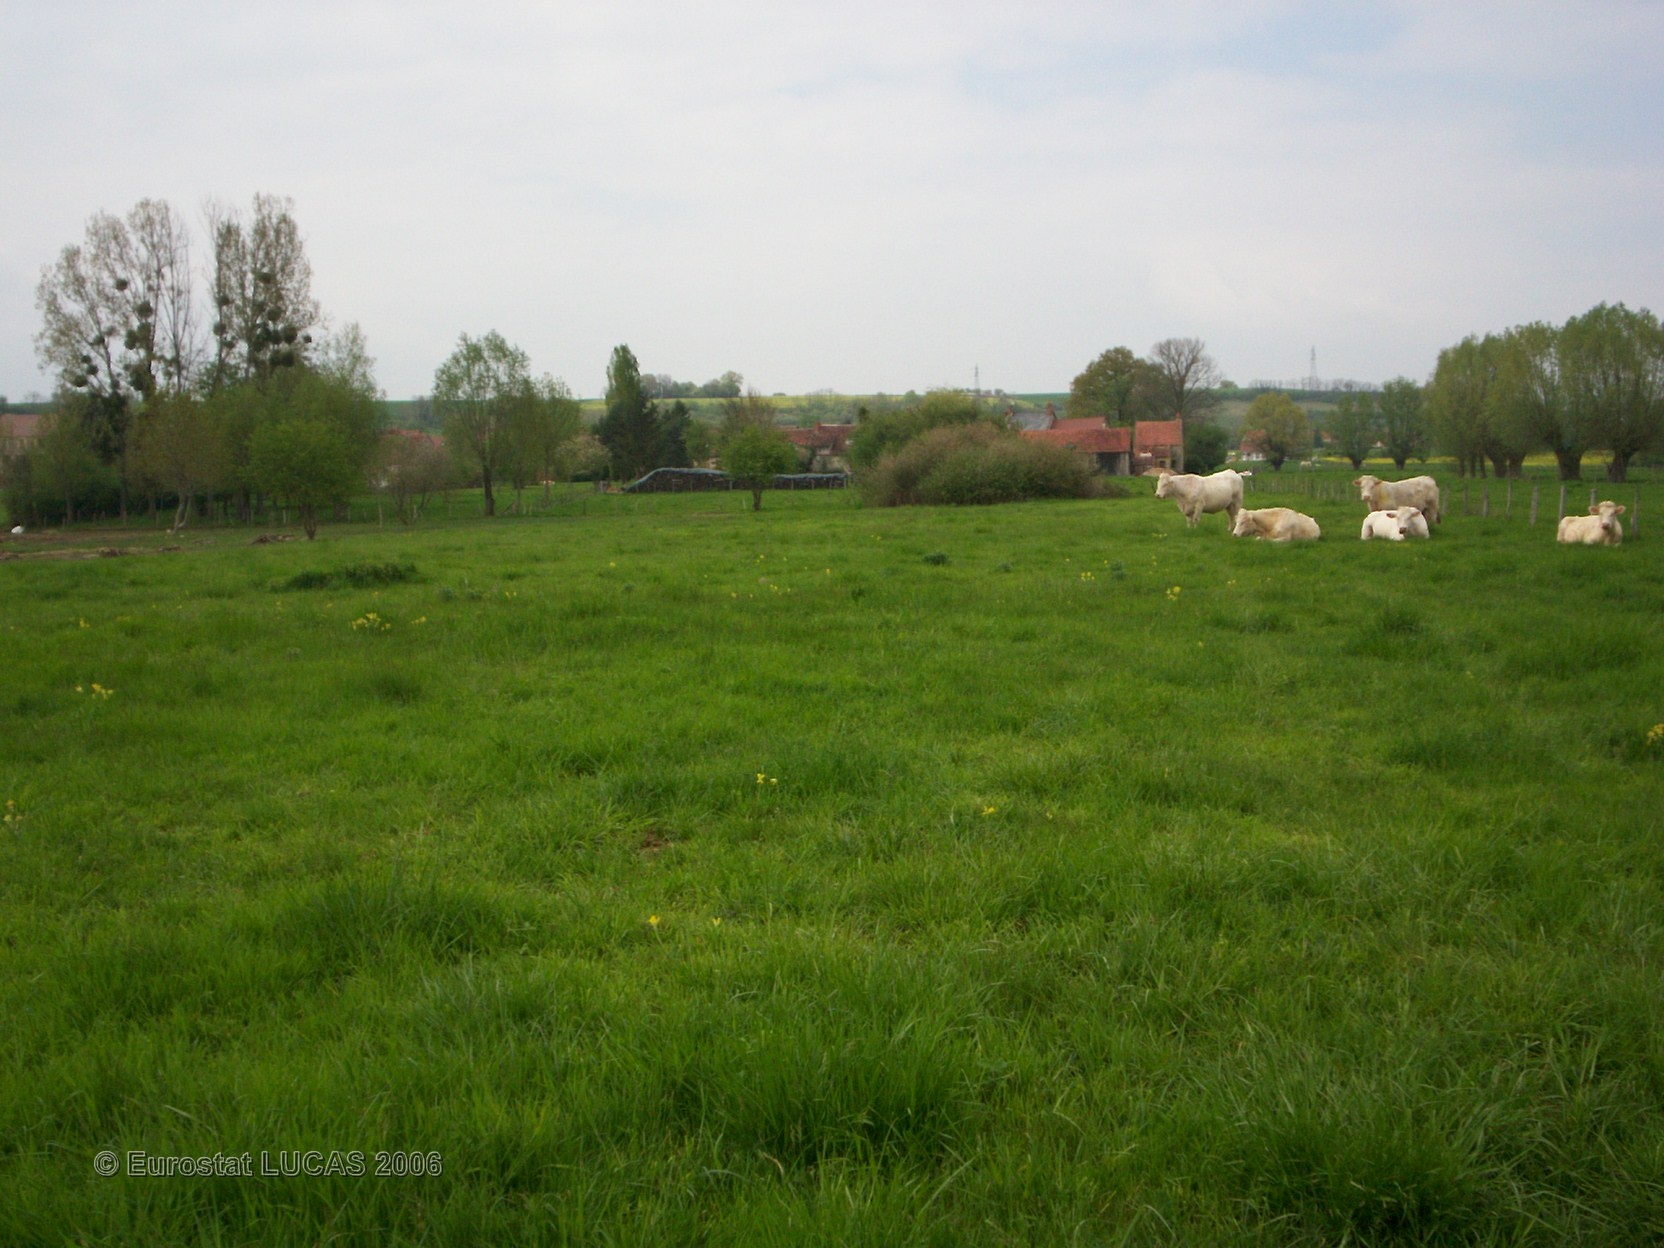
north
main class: Grassland
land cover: Grassland with sparse tree/shrub cover
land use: Agriculture (excluding fallow land and kitchen gardens)
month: April
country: FR
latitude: 47.0831
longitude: 3.0542
